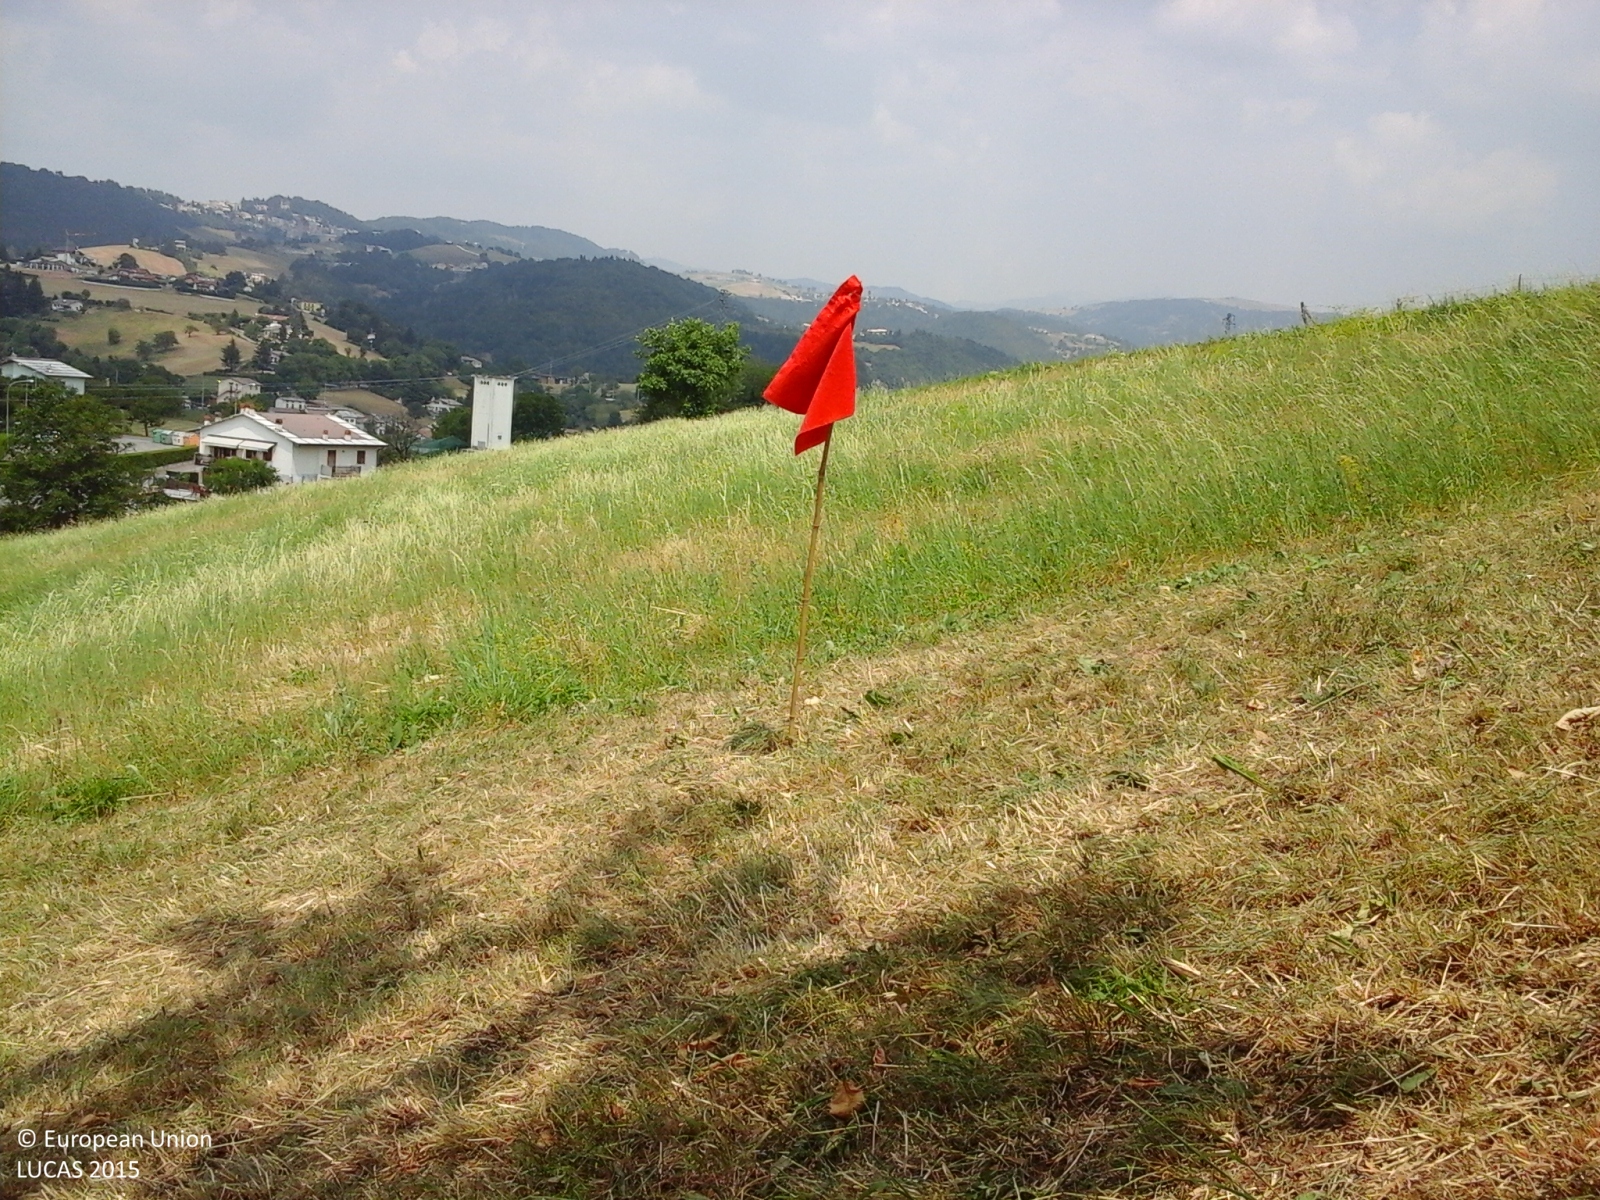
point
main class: Grassland
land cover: Grassland with sparse tree/shrub cover
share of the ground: > 75 %
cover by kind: herbaceous plants 85 %, shrubs 10 %, broadleaved forest trees 5 %
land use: Agriculture (excluding fallow land and kitchen gardens)
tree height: > 5 m
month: July
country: IT
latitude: 45.5894
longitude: 11.0366
